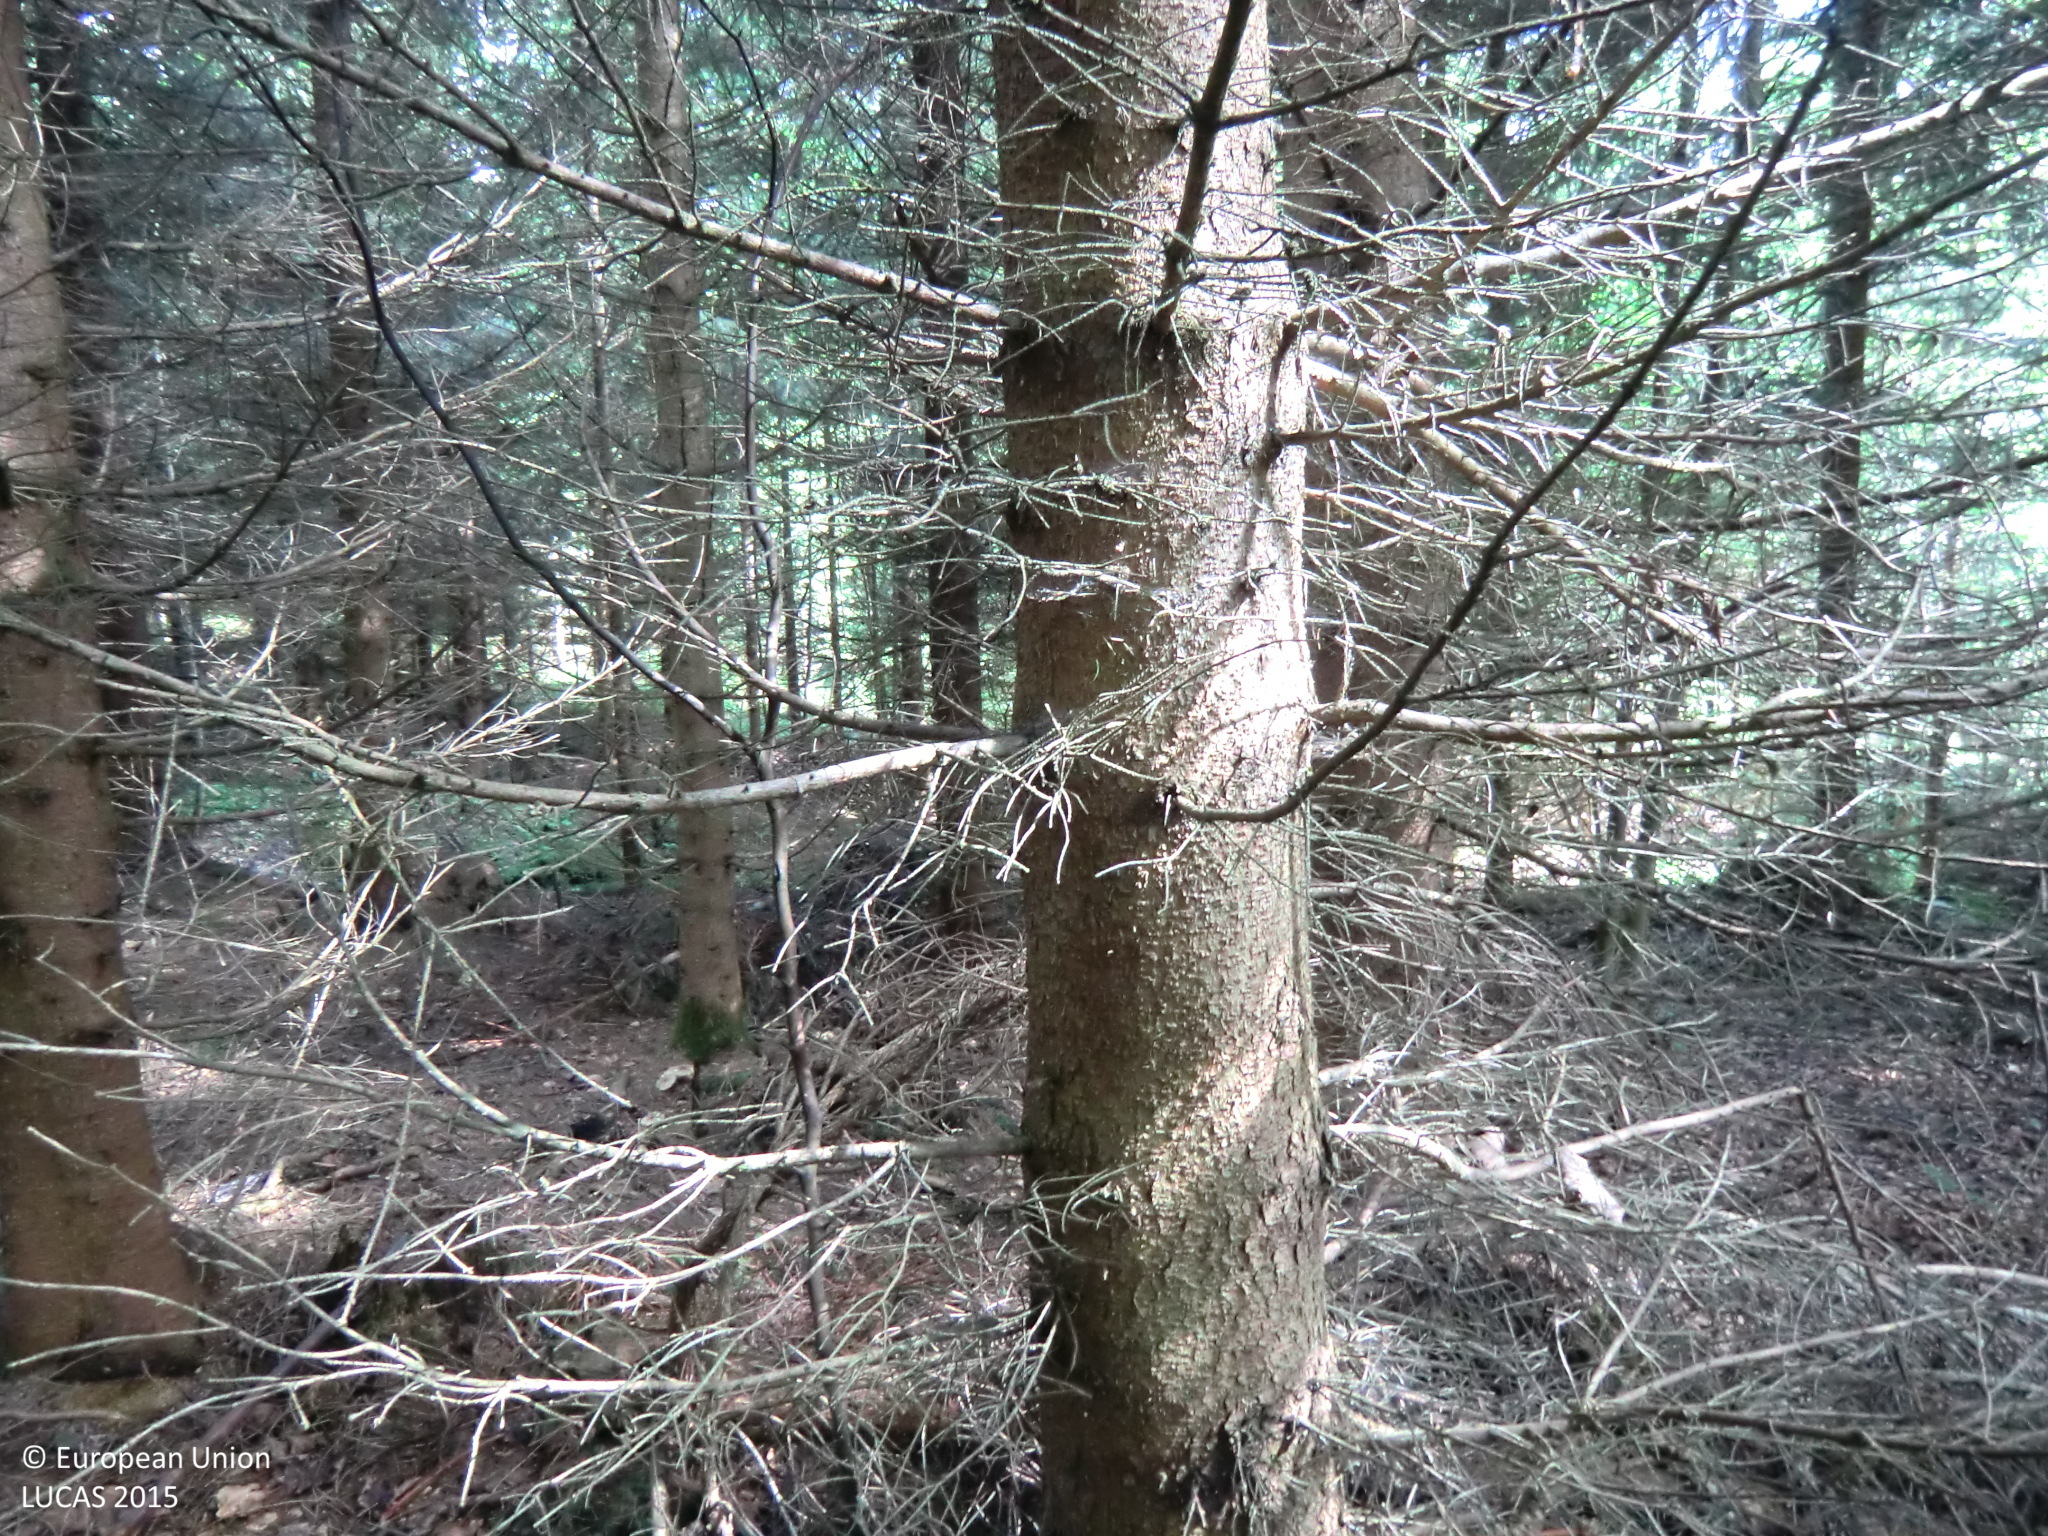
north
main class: Woodland
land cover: Spruce dominated coniferous woodland
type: hemiboreal forest and nemoral coniferous forest and mixed broadleaved-coniferous forest
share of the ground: > 75 %
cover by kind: coniferous forest trees 90 %, broadleaved forest trees 10 %
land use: Forestry
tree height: > 5 m
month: June
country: AT
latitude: 48.4770
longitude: 14.8577
